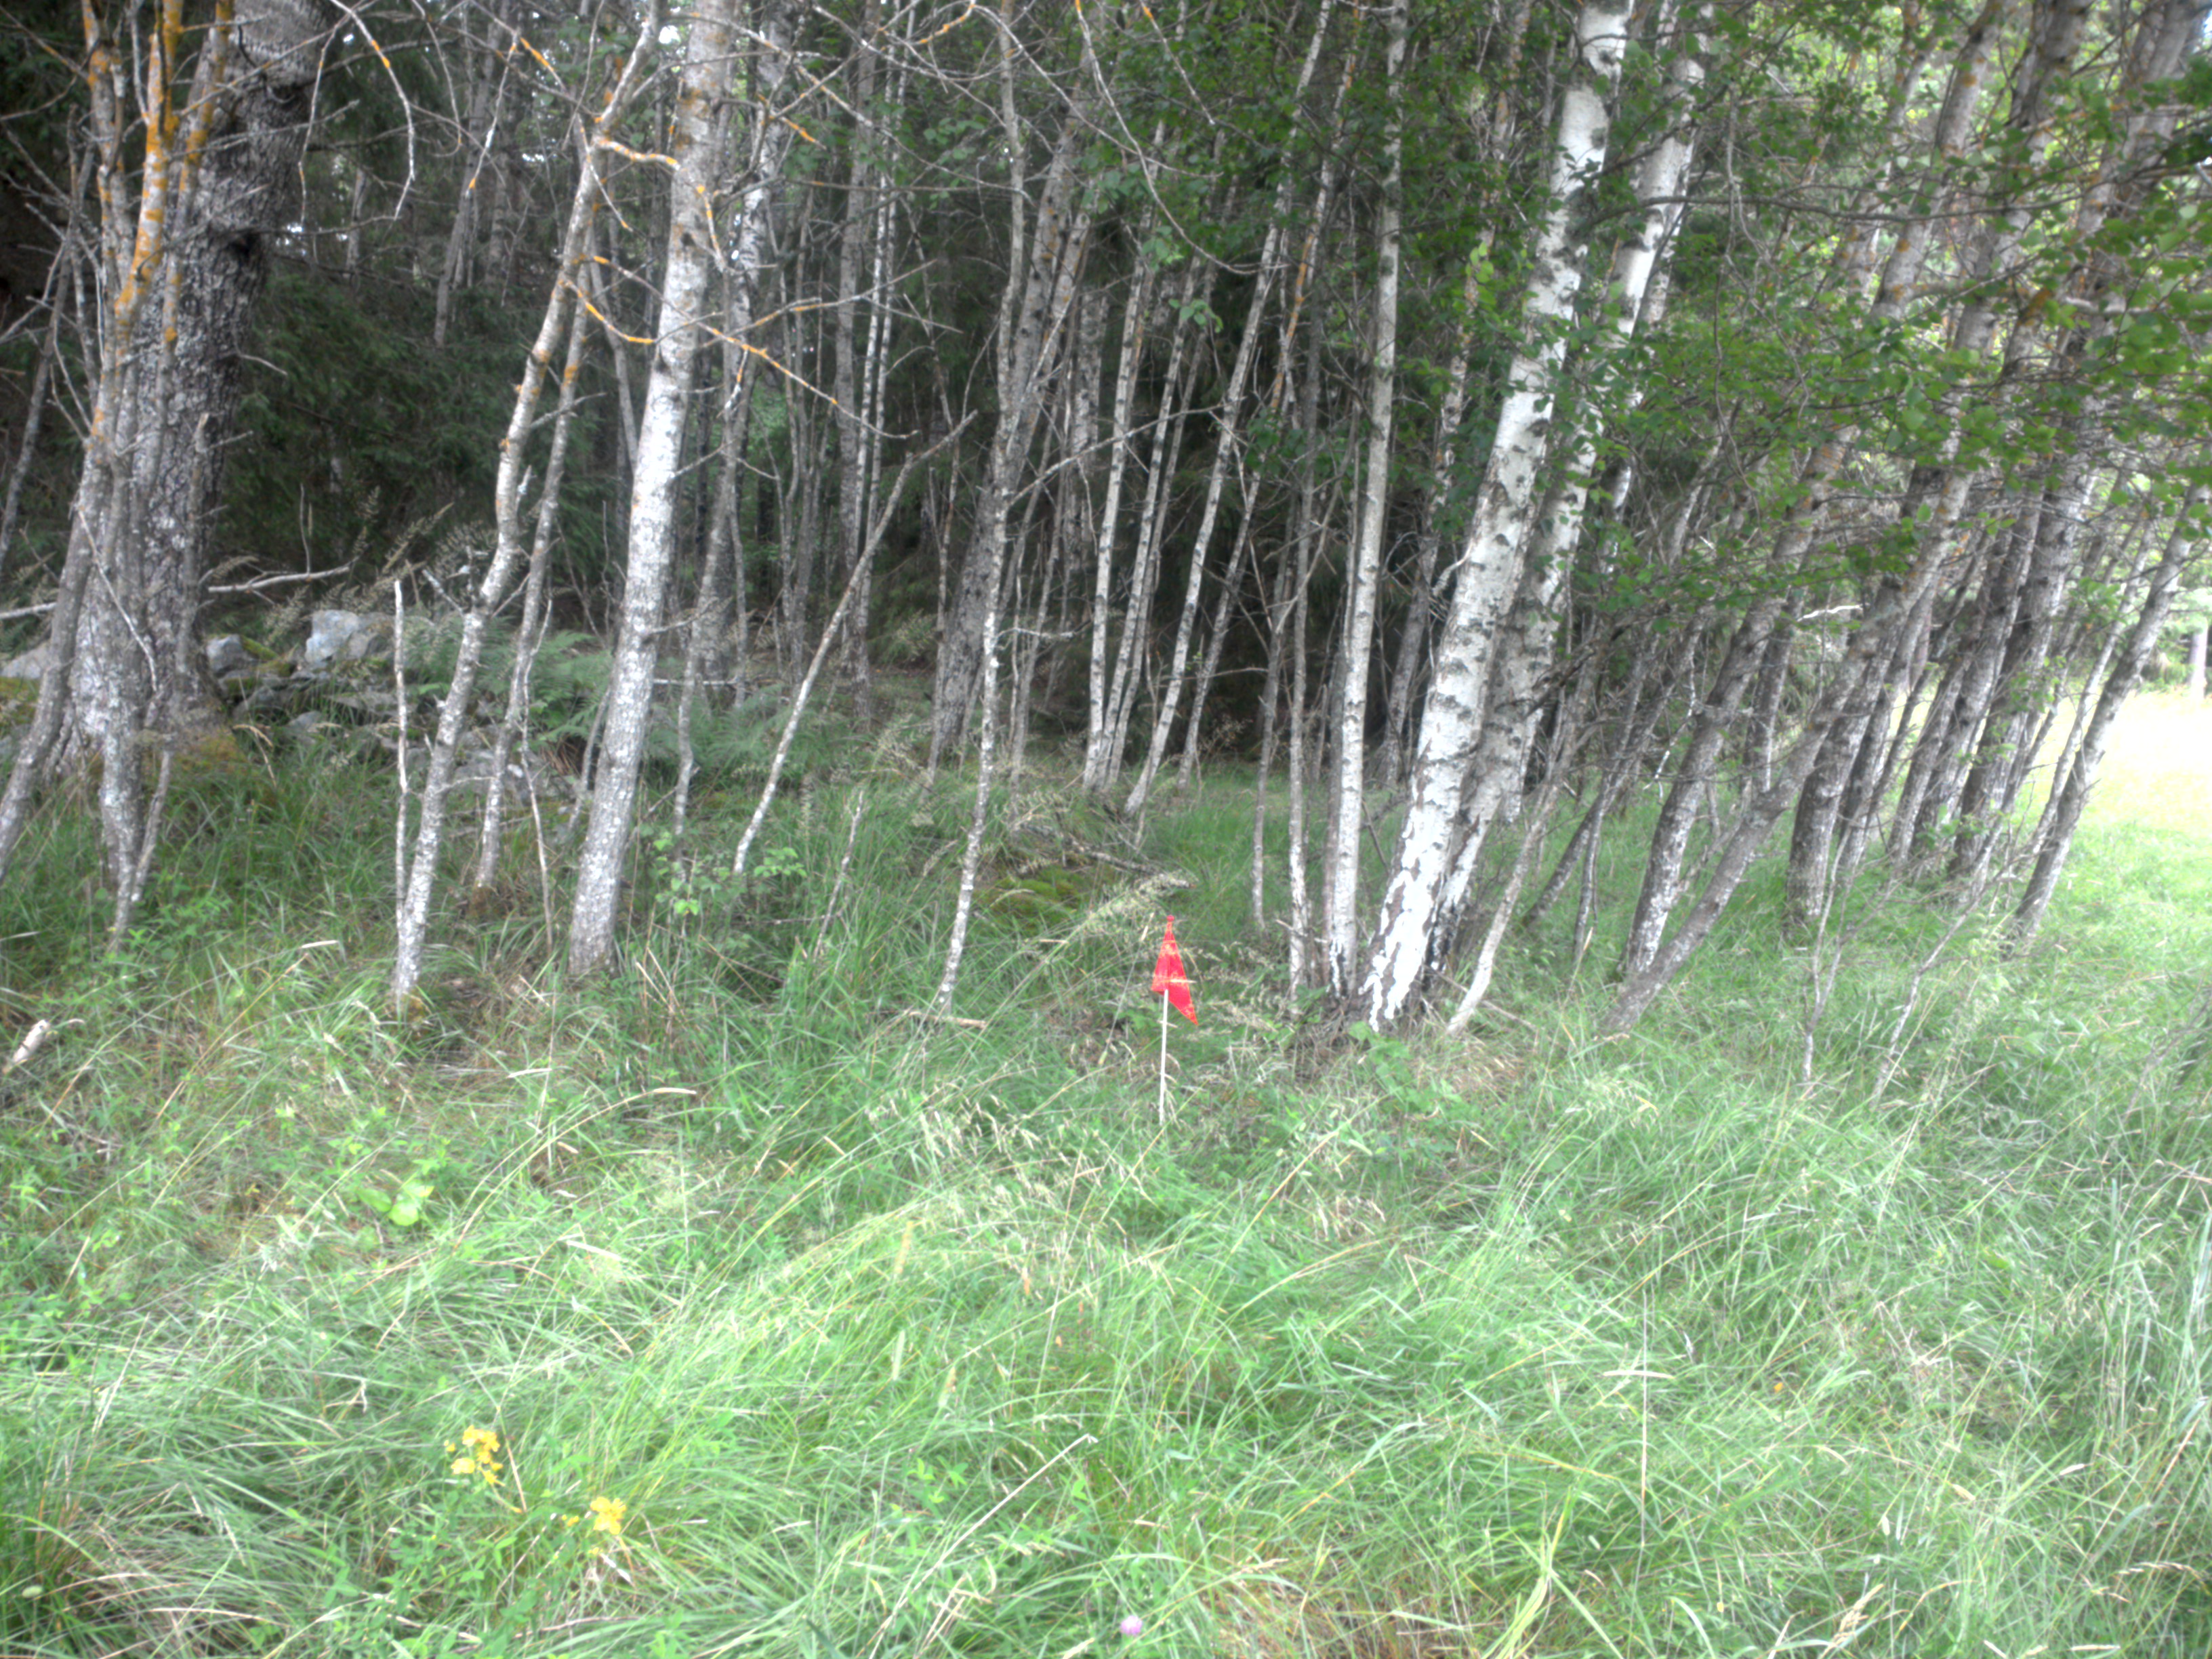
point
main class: Woodland
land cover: Broadleaved woodland
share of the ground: > 75 %
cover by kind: broadleaved forest trees 90 %, herbaceous plants 5 %, lichens and mosses 5 %
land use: Amenities, museums, leisure
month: July
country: SE
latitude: 59.2124
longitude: 18.2851
